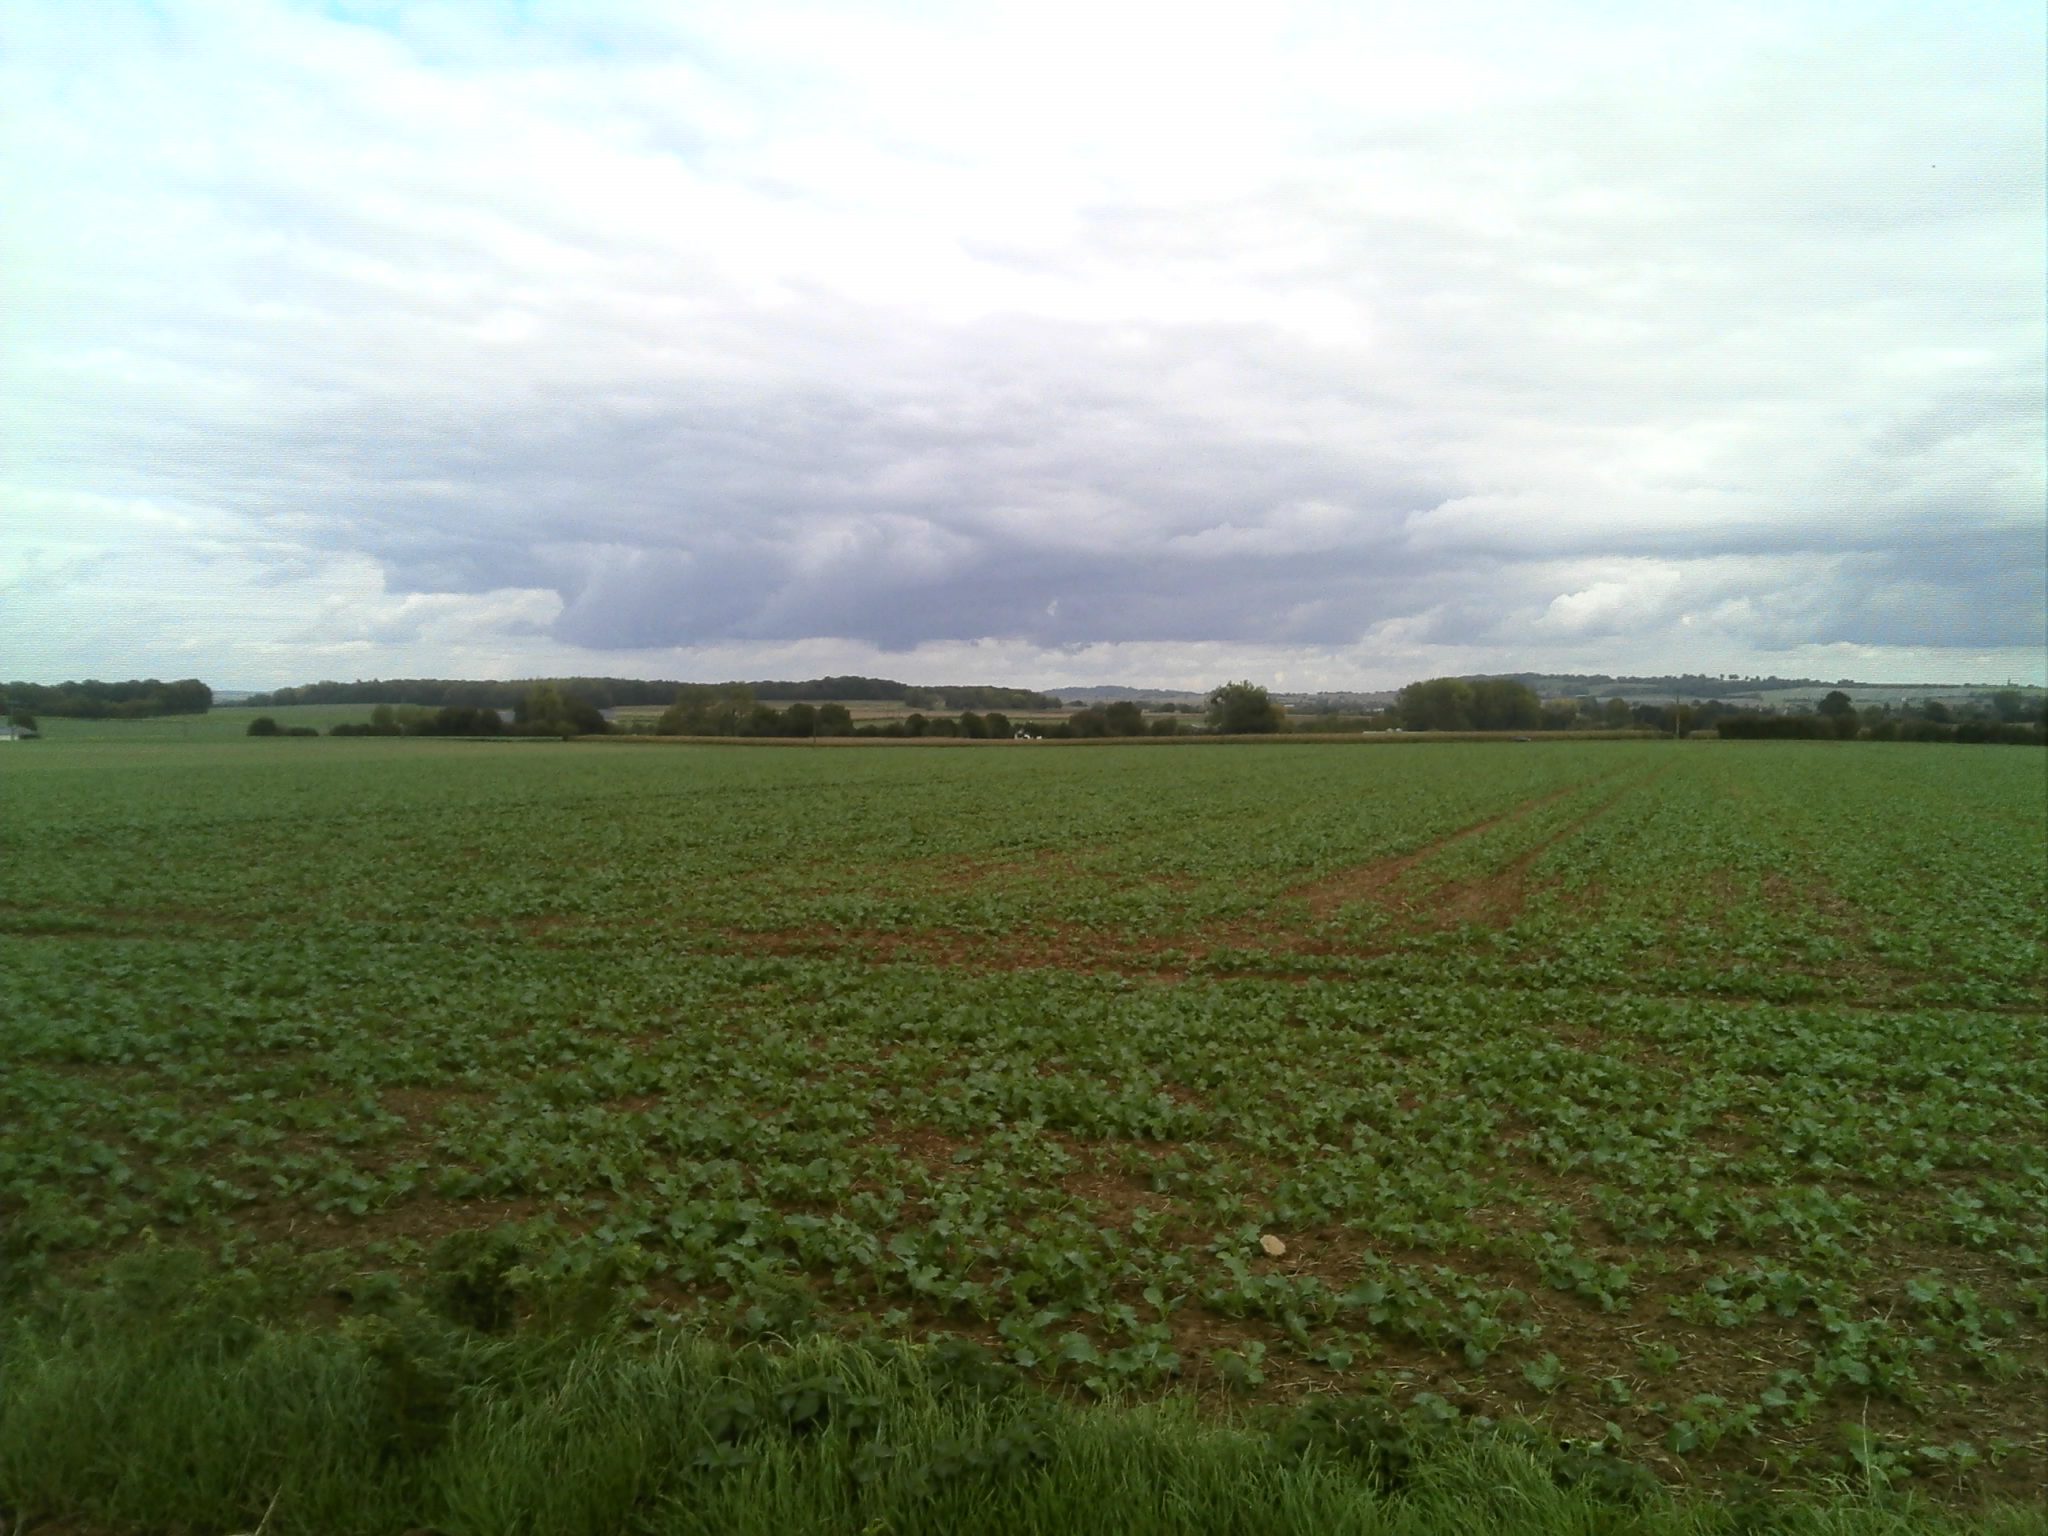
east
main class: Cropland
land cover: Rape and turnip rape
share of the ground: 50 - 75 %
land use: Agriculture (excluding fallow land and kitchen gardens)
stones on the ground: 10 - 25 %
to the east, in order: Rape and turnip rape; Grass margins; Rape and turnip rape
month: October
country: FR
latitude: 48.0661
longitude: -0.1074
